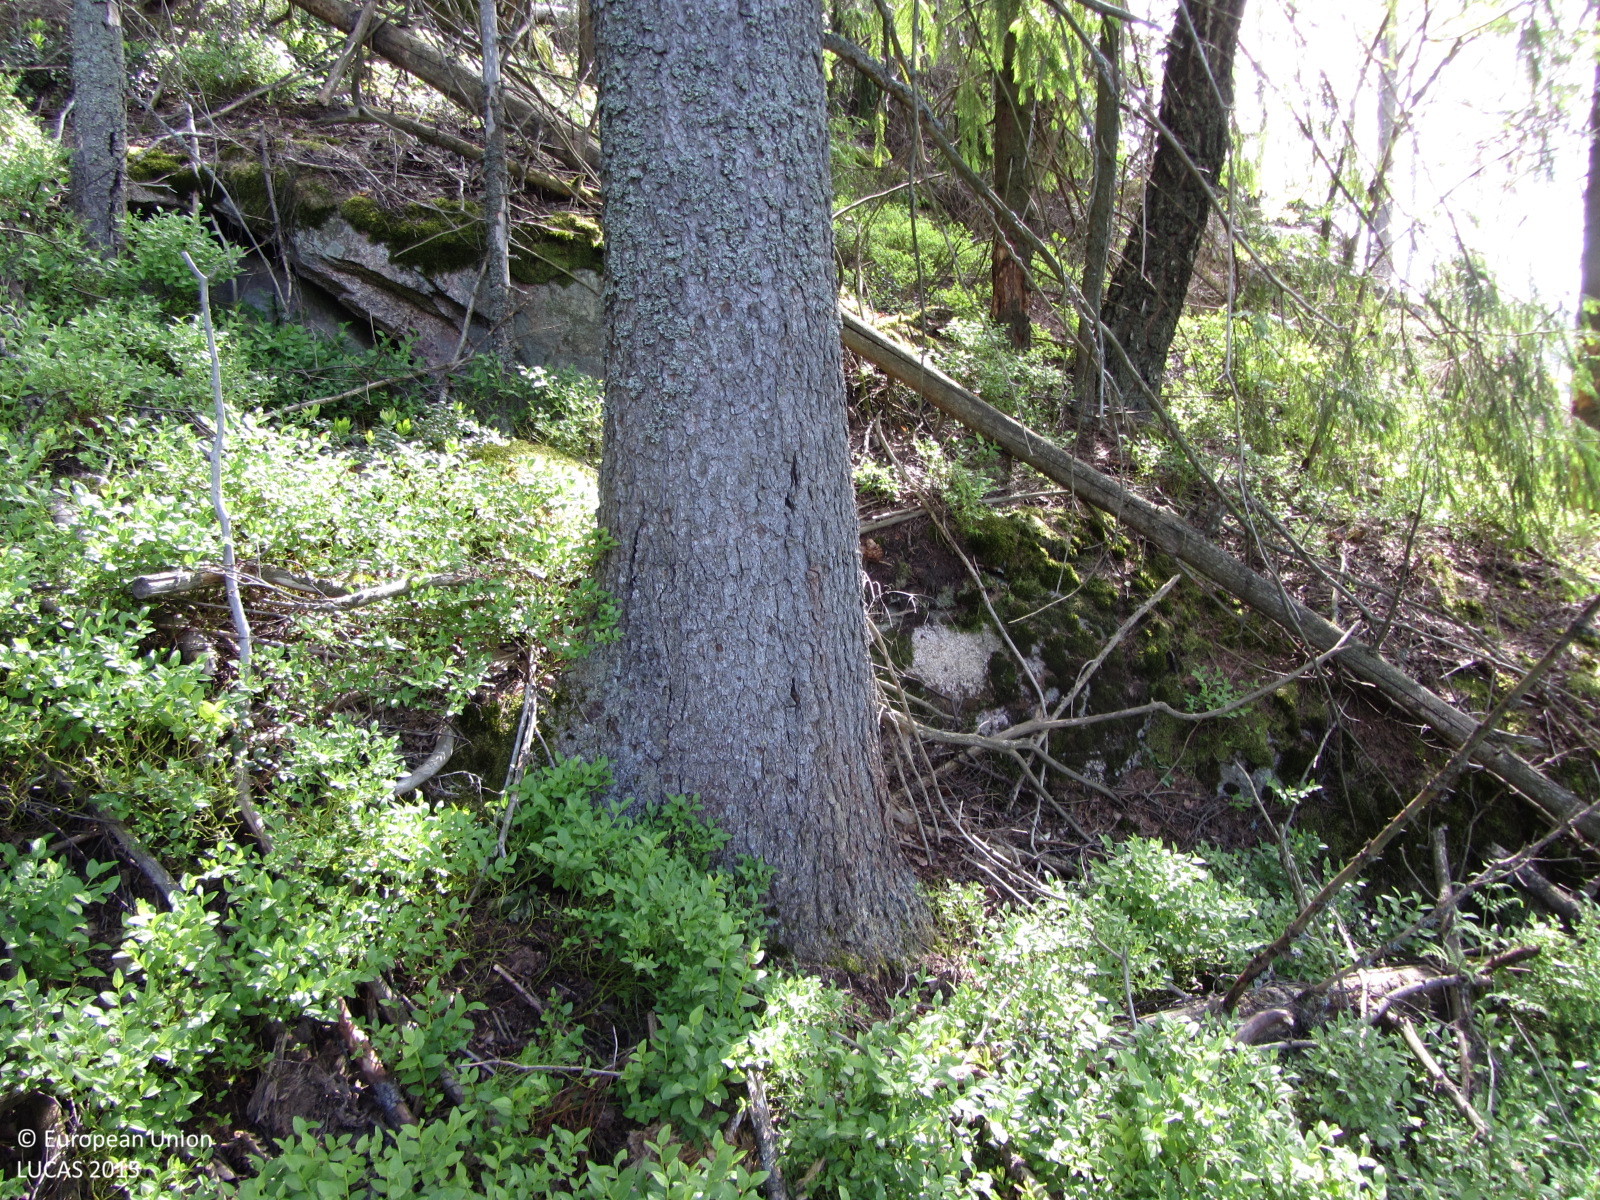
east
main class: Woodland
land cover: Spruce dominated mixed woodland
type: boreal forest
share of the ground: > 75 %
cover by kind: broadleaved forest trees 45 %, coniferous forest trees 40 %, shrubs 10 %, herbaceous plants 5 %
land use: Forestry
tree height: > 5 m
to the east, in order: Spruce dominated mixed woodland; Other mixed woodland; Spruce dominated mixed woodland; Other mixed woodland; Other coniferous woodland
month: June
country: FI
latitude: 60.1707
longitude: 24.2148
